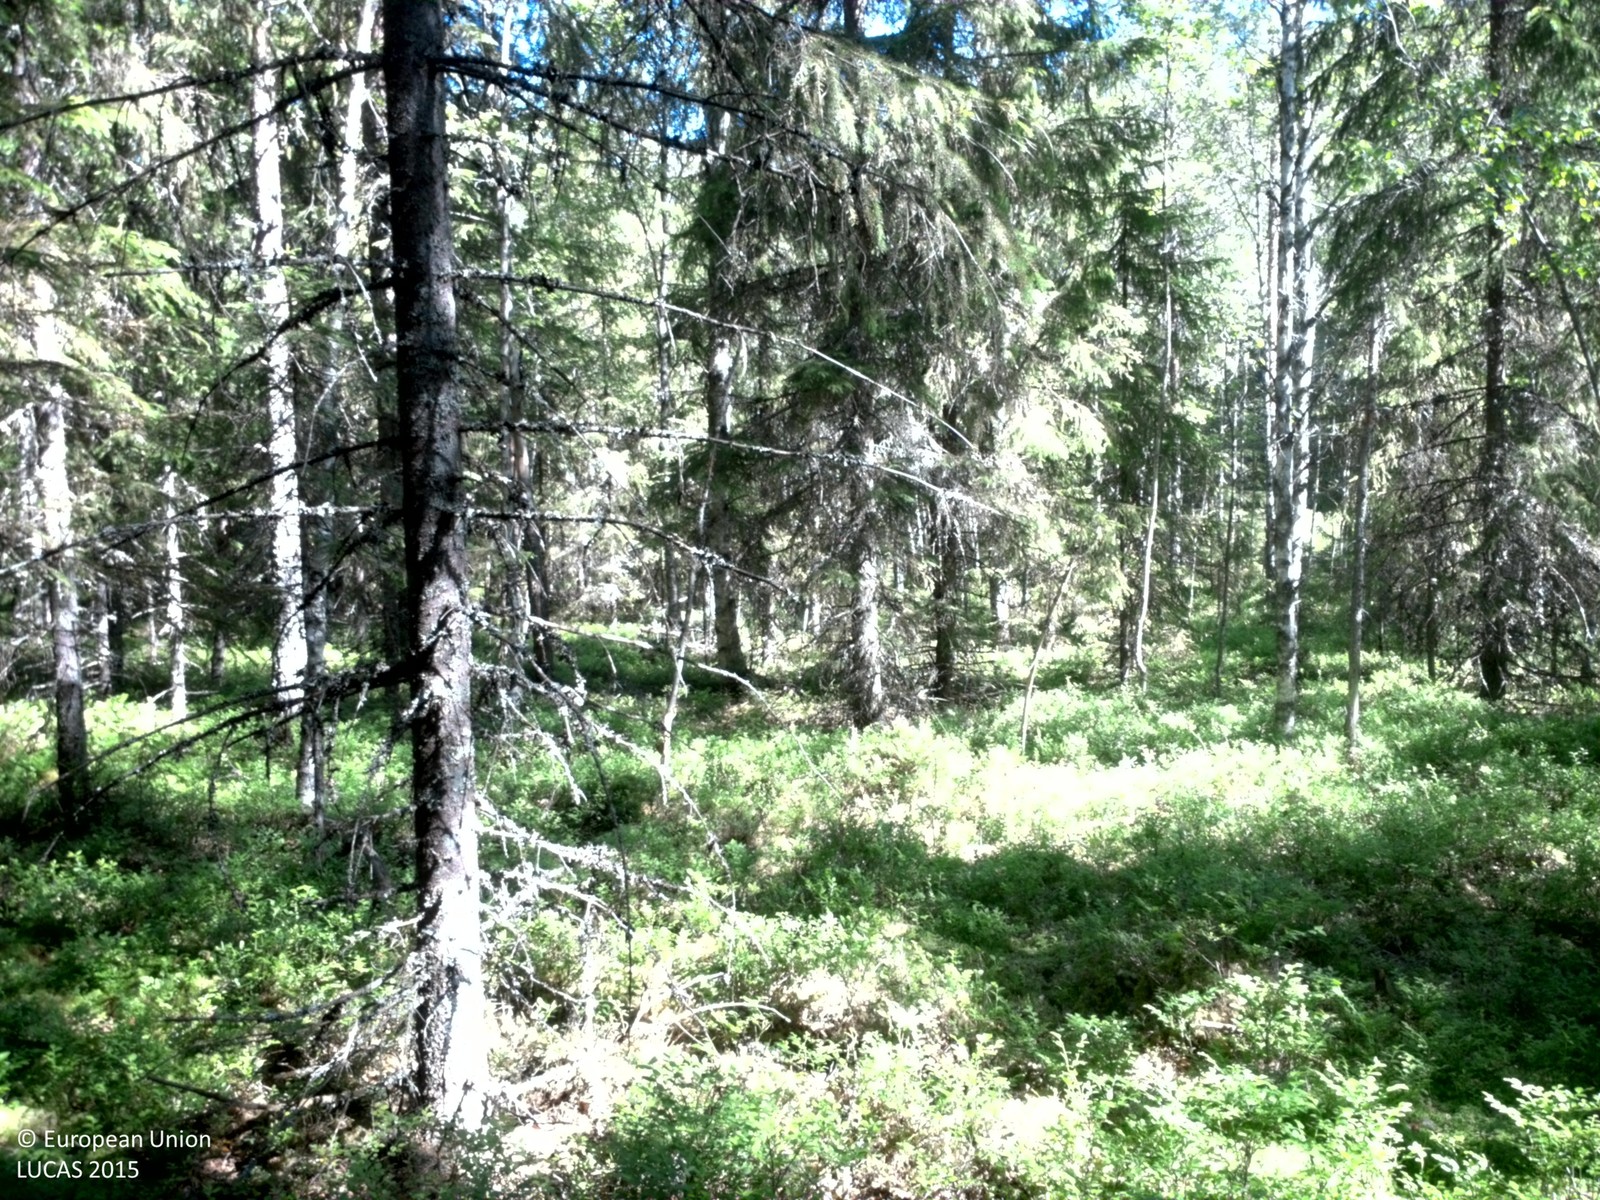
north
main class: Woodland
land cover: Spruce dominated mixed woodland
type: boreal forest
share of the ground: 50 - 75 %
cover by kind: coniferous forest trees 45 %, shrubs 25 %, broadleaved forest trees 15 %, lichens and mosses 15 %
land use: Forestry
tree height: > 5 m
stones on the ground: < 10 %
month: July
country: SE
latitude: 59.7712
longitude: 11.9356
